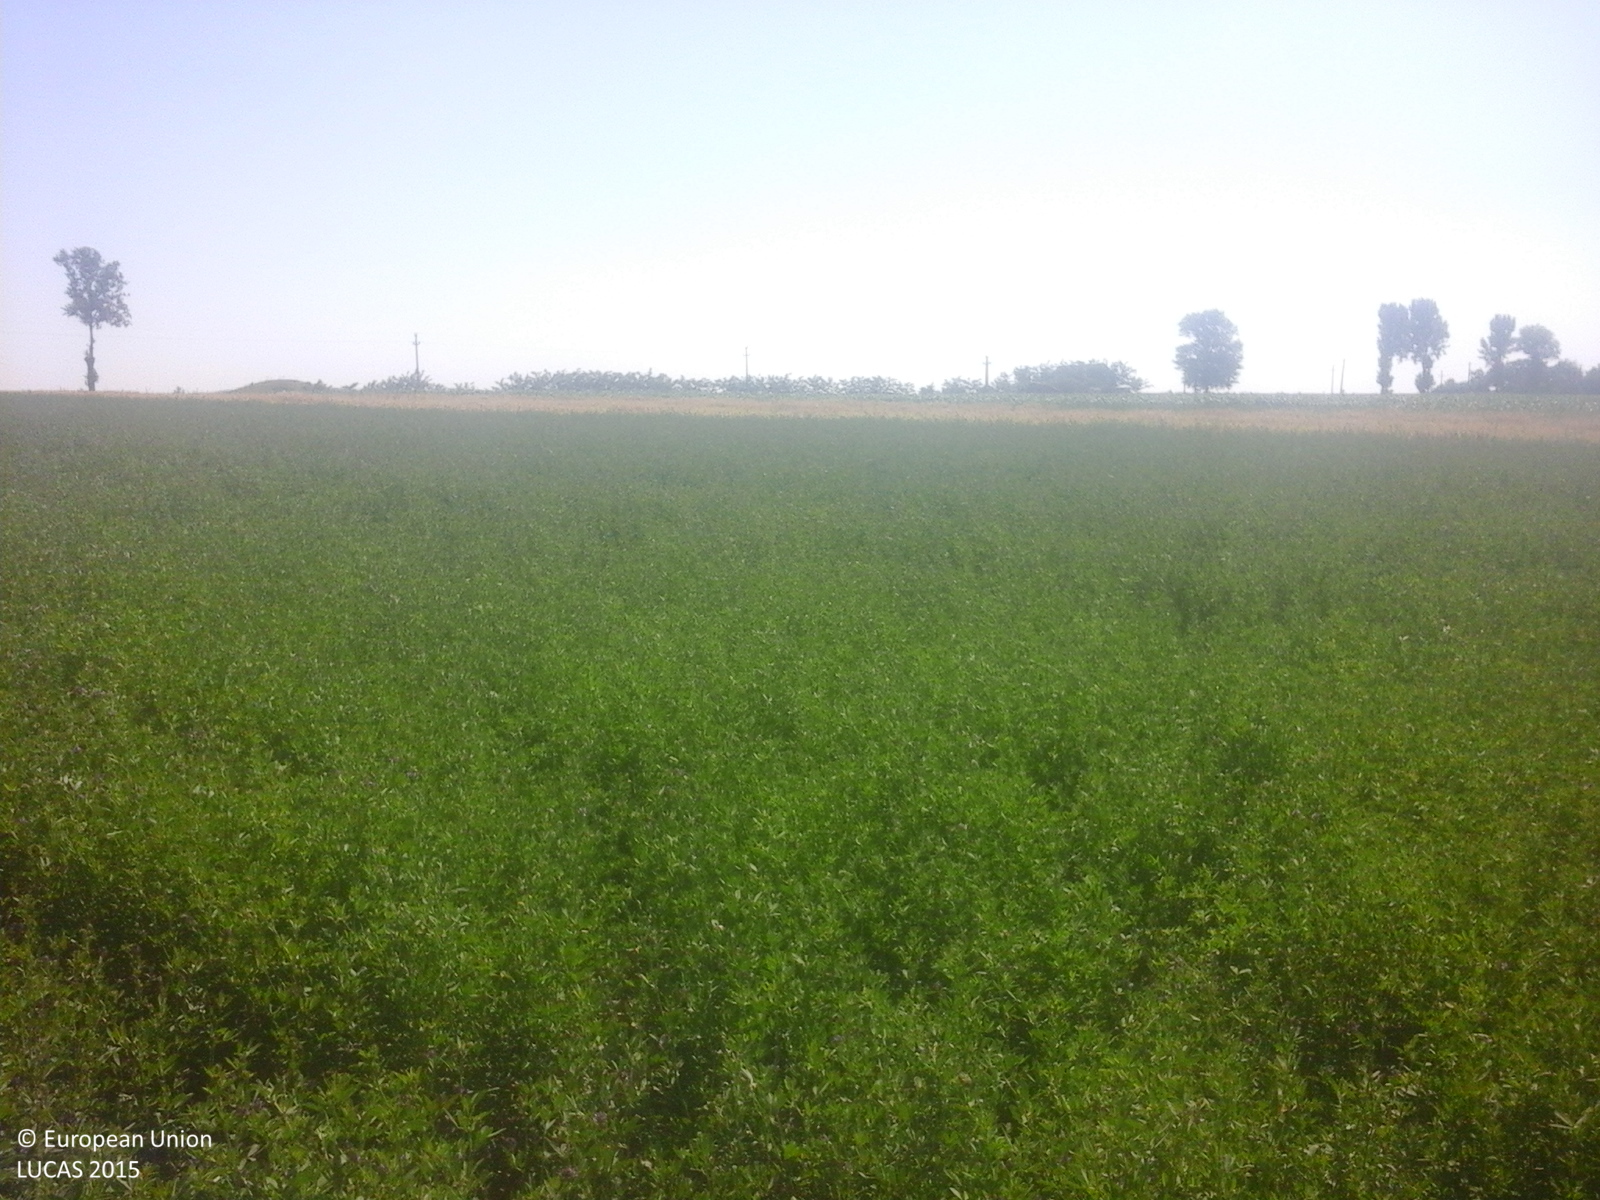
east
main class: Cropland
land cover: Lucerne
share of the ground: > 75 %
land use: Agriculture (excluding fallow land and kitchen gardens)
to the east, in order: Lucerne; Common wheat; Lucerne; Maize; Lucerne; Maize; Lines of trees; Grass margins; Ditches and canals; Tracks; Ditches and canals
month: June
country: RO
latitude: 47.8282
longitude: 27.1140
